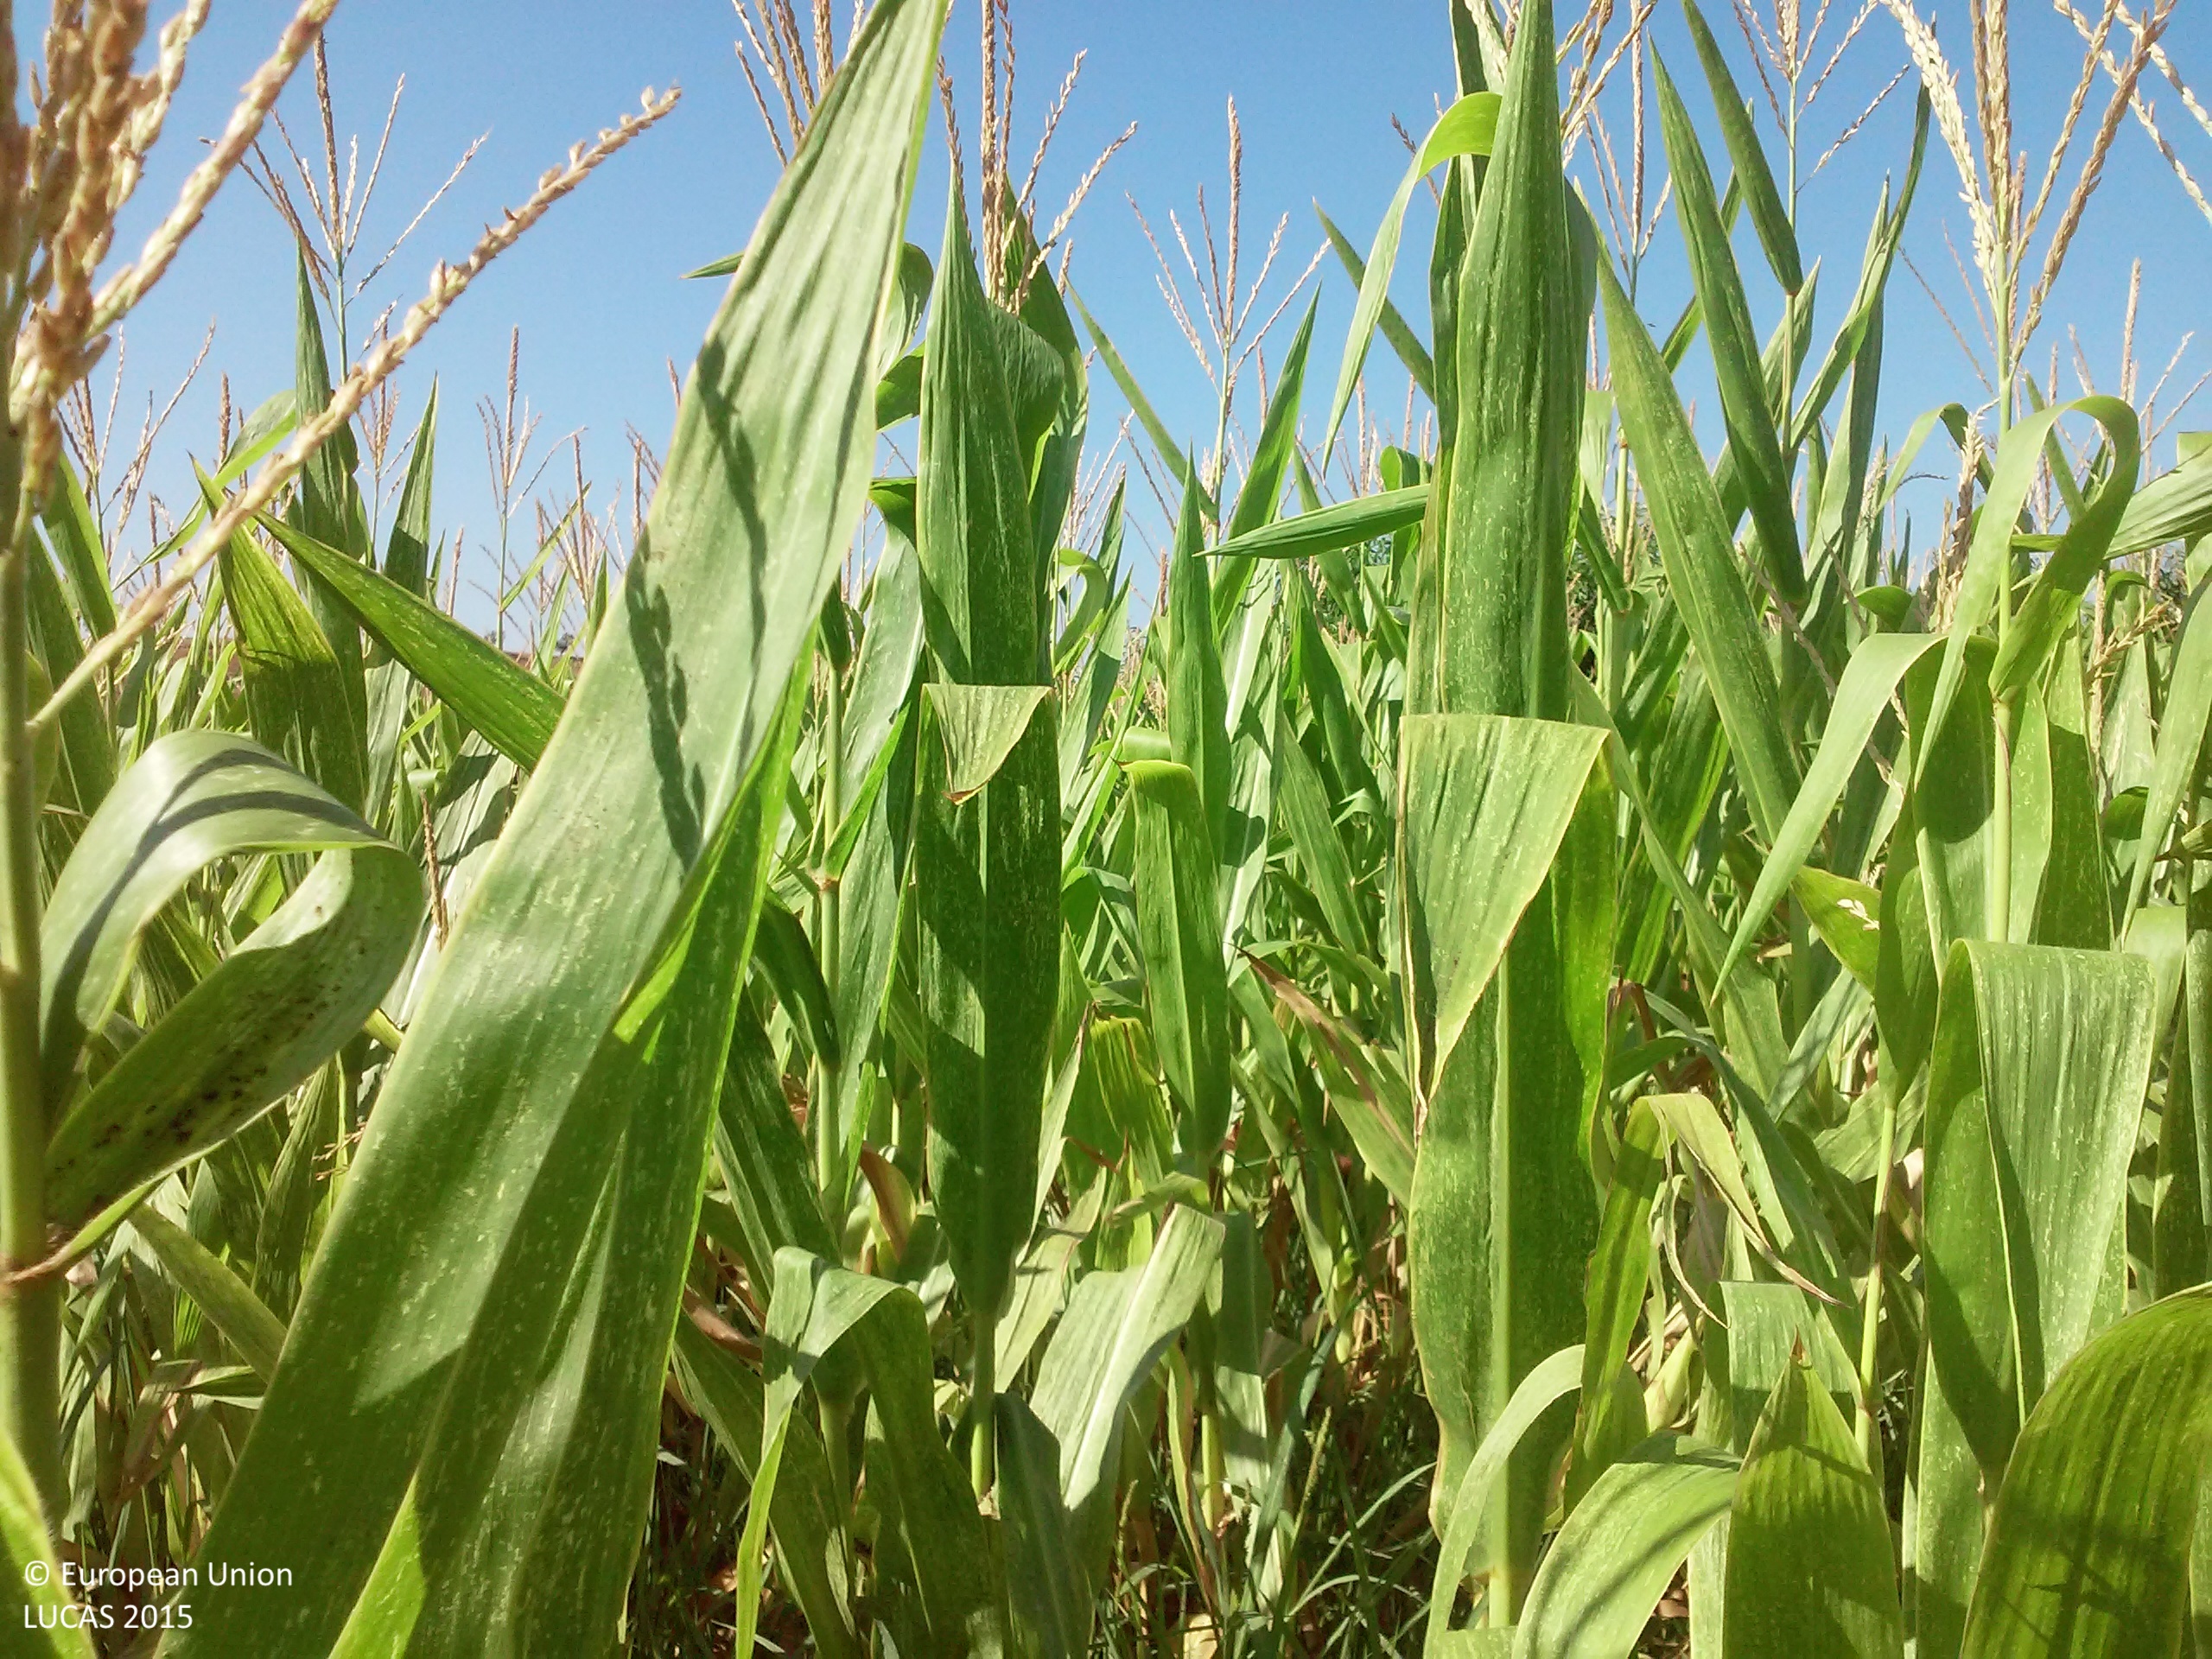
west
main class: Cropland
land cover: Maize
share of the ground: > 75 %
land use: Agriculture (excluding fallow land and kitchen gardens)
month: July
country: ES
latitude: 41.6960
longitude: 0.6751
